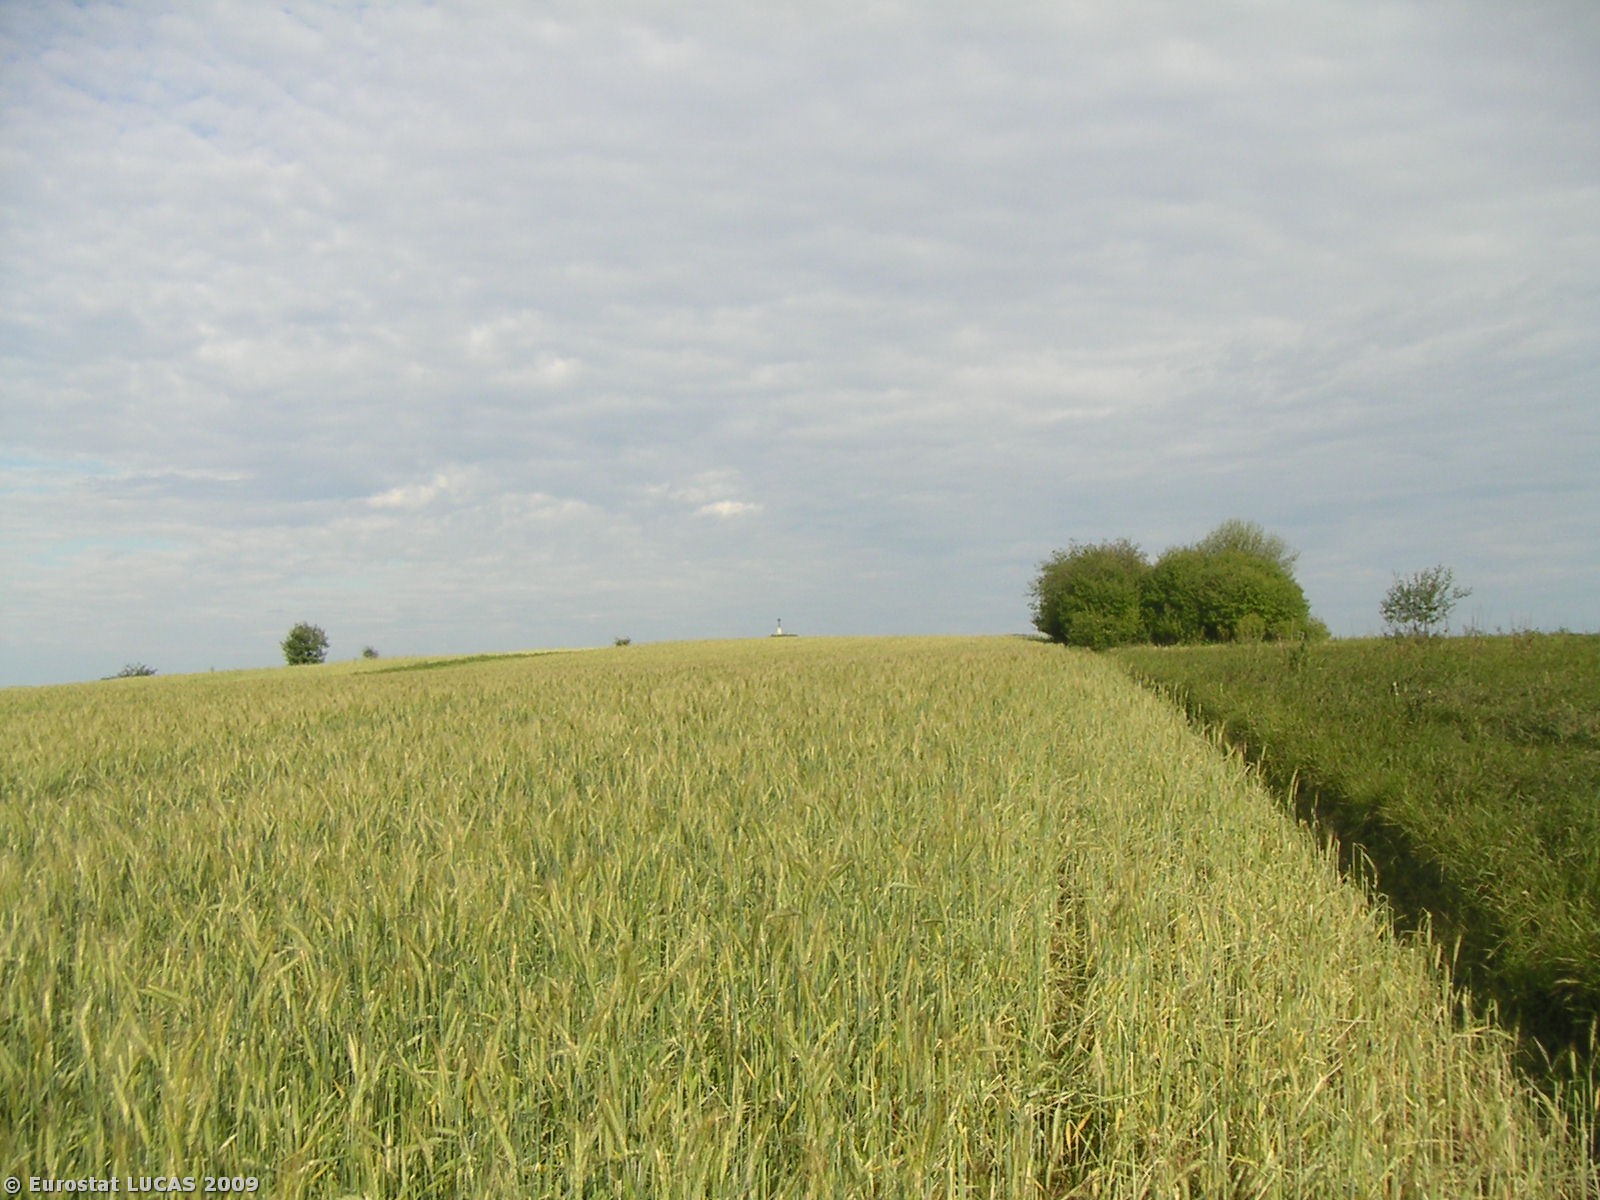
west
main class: Cropland
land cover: Triticale
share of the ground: > 75 %
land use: Agriculture (excluding fallow land and kitchen gardens)
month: June
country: PL
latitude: 50.1632
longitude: 19.7589
